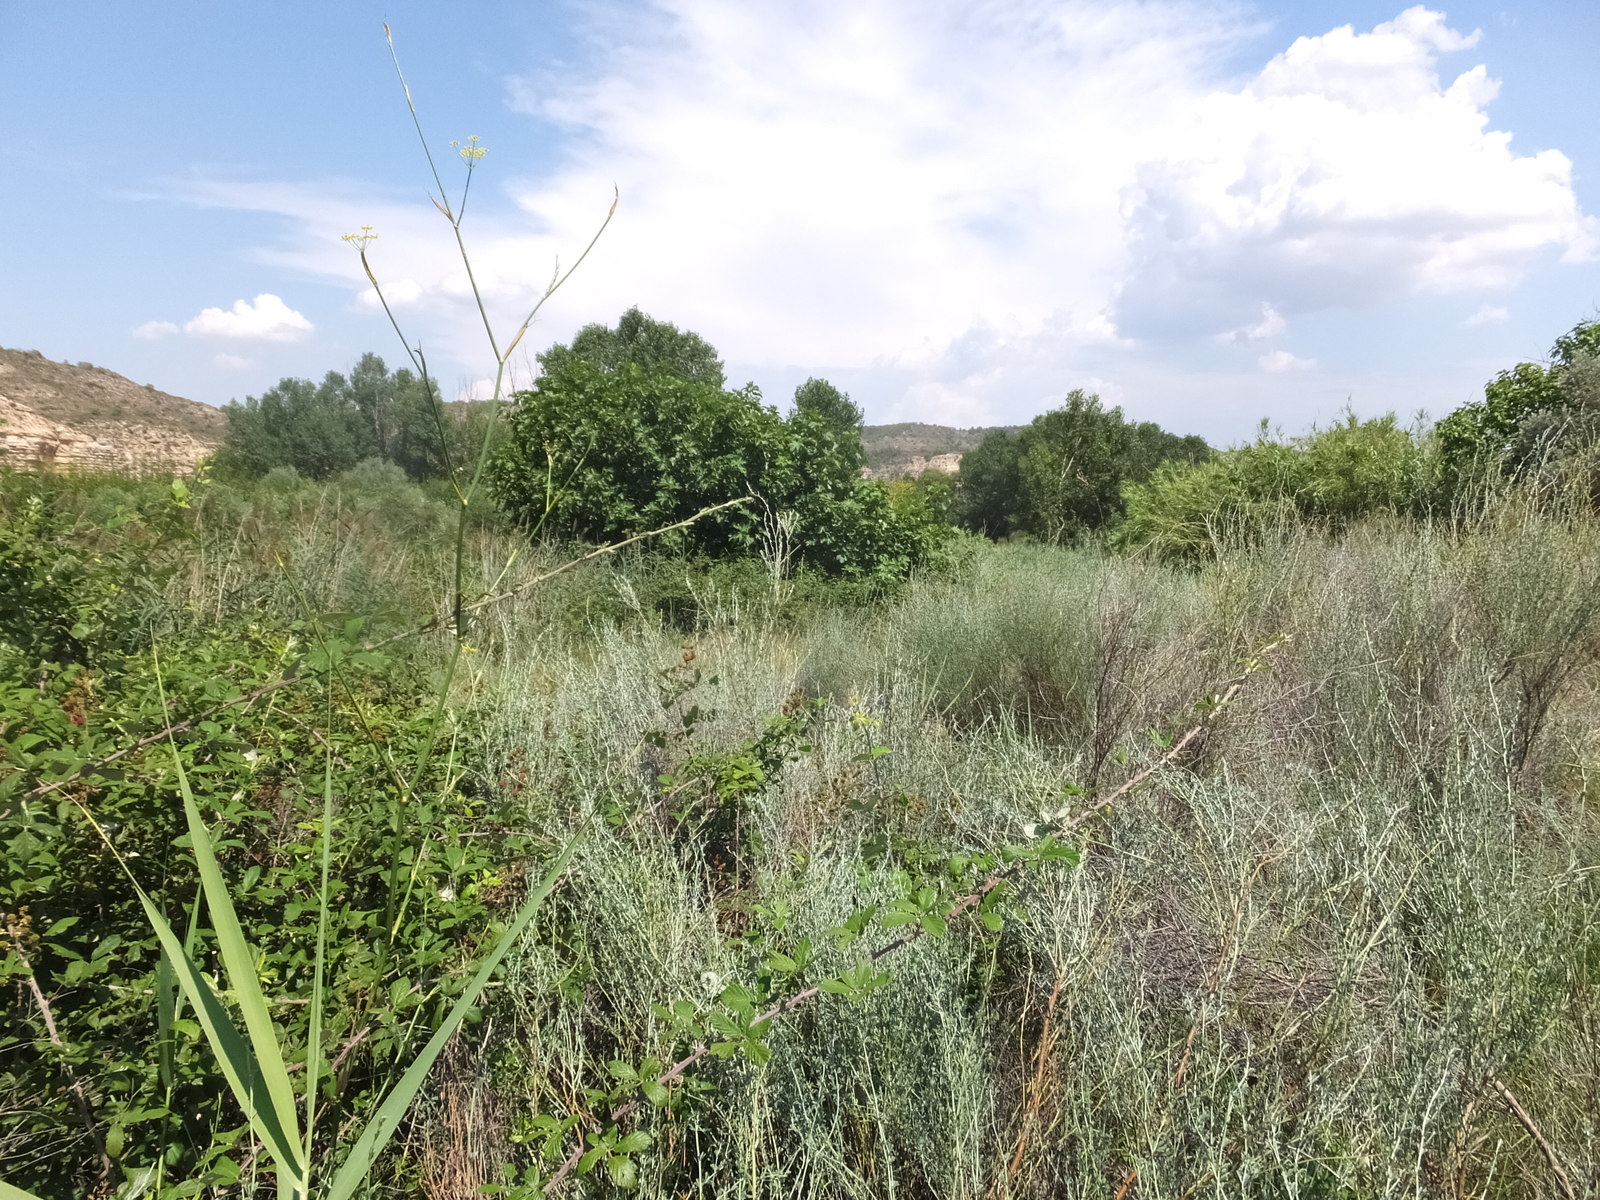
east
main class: Shrubland
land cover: Shrubland without tree cover
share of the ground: > 75 %
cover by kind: shrubs 75 %, herbaceous plants 25 %
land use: Semi-natural and natural areas not in use
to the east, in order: Shrubland without tree cover; Tracks; Spontaneously vegetated surfaces; Inland fresh running water; Broadleaved woodland; Grassland without tree/shrub cover; Artificial constructions in urban areas
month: July
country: ES
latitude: 41.2314
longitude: 0.1940
